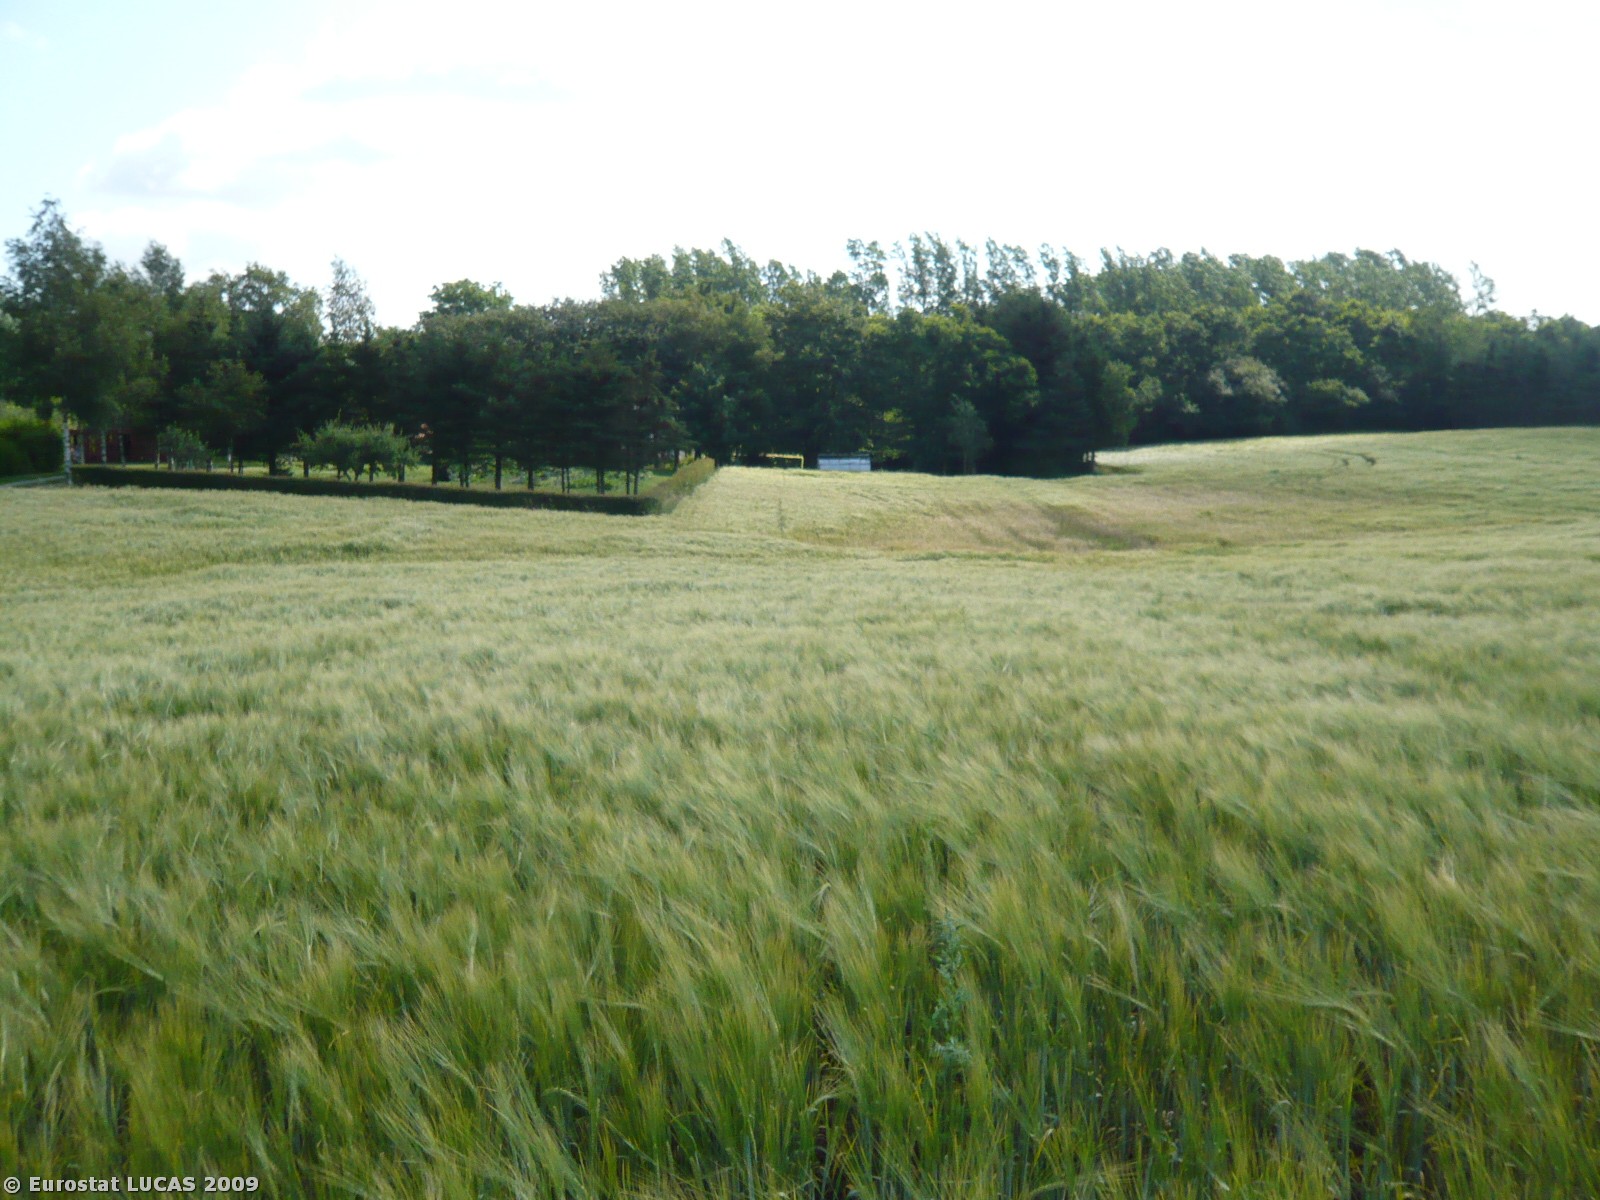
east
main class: Cropland
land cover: Barley
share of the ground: 25 - 50 %
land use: Agriculture (excluding fallow land and kitchen gardens)
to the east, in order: Barley; Coniferous woodland; Artificial constructions in urban areas; Coniferous woodland; Broadleaved woodland; Grassland without tree/shrub cover; Grassland with sparse tree/shrub cover
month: July
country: DK
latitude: 55.6564
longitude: 11.6038
